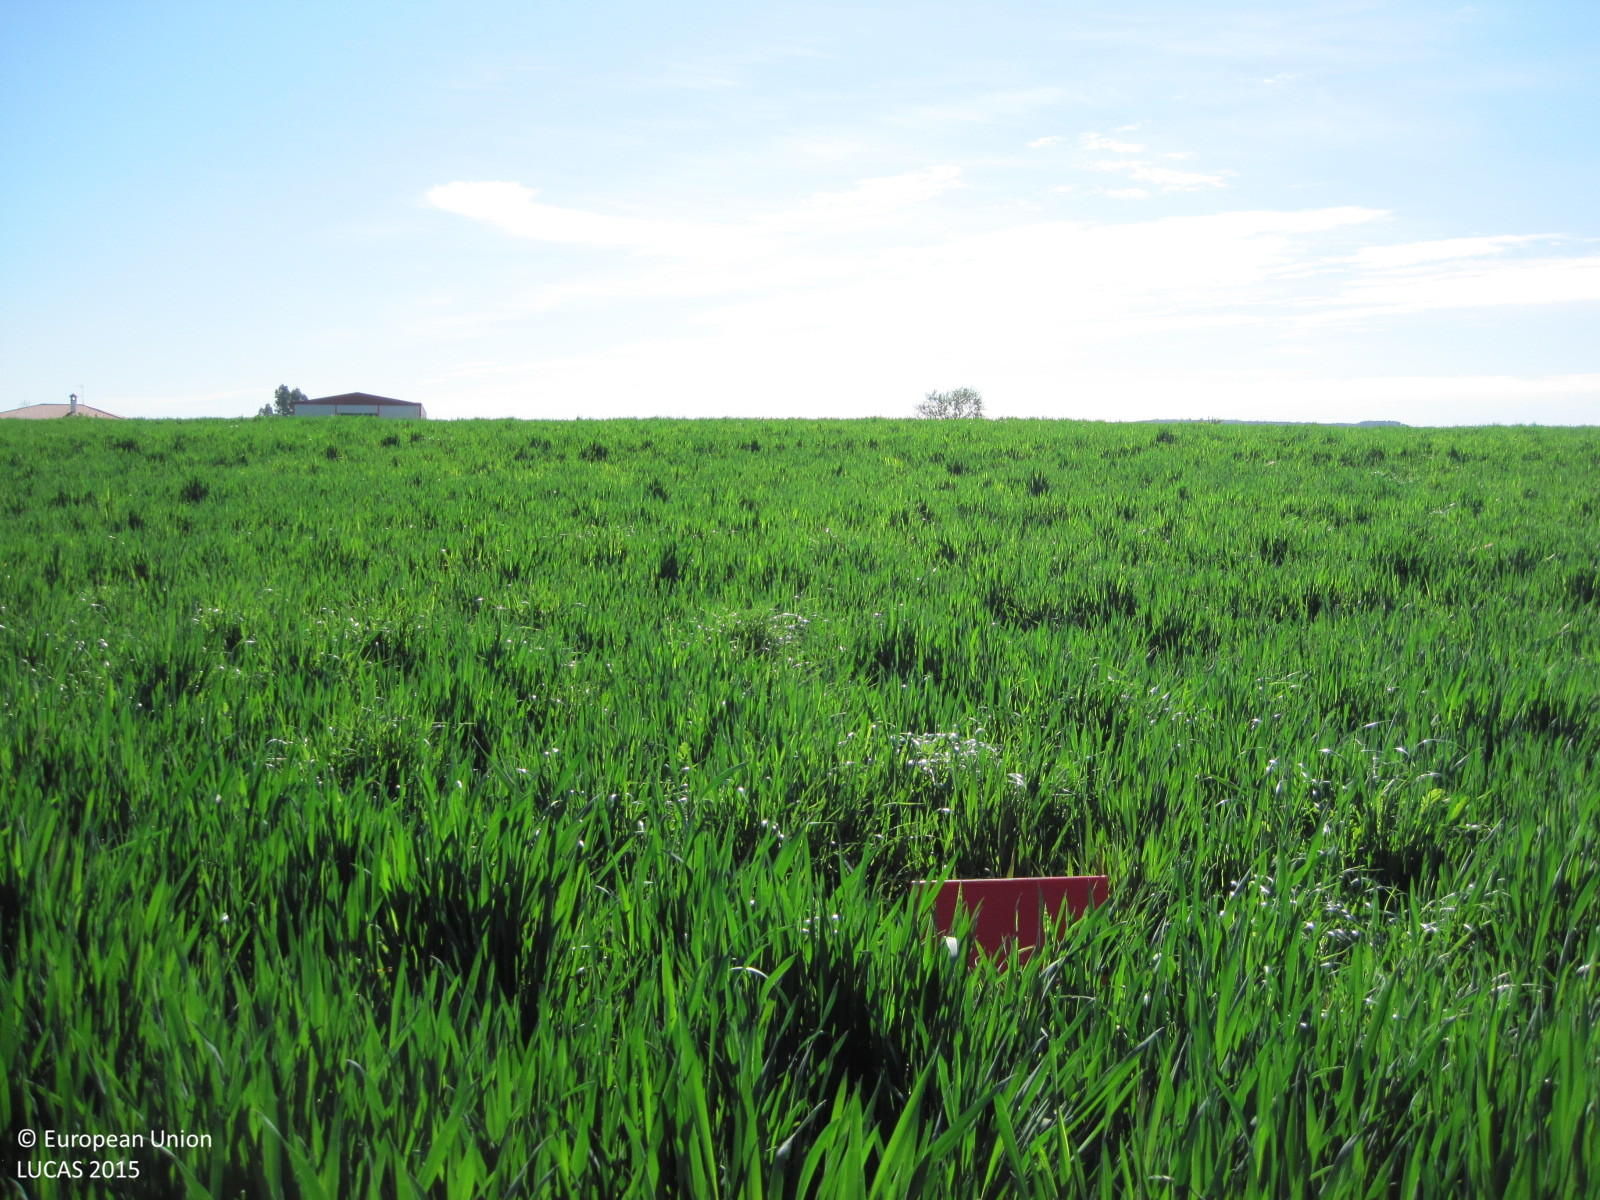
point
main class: Cropland
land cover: Barley
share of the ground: > 75 %
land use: Agriculture (excluding fallow land and kitchen gardens)
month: April
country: ES
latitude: 39.9696
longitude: -4.7639
